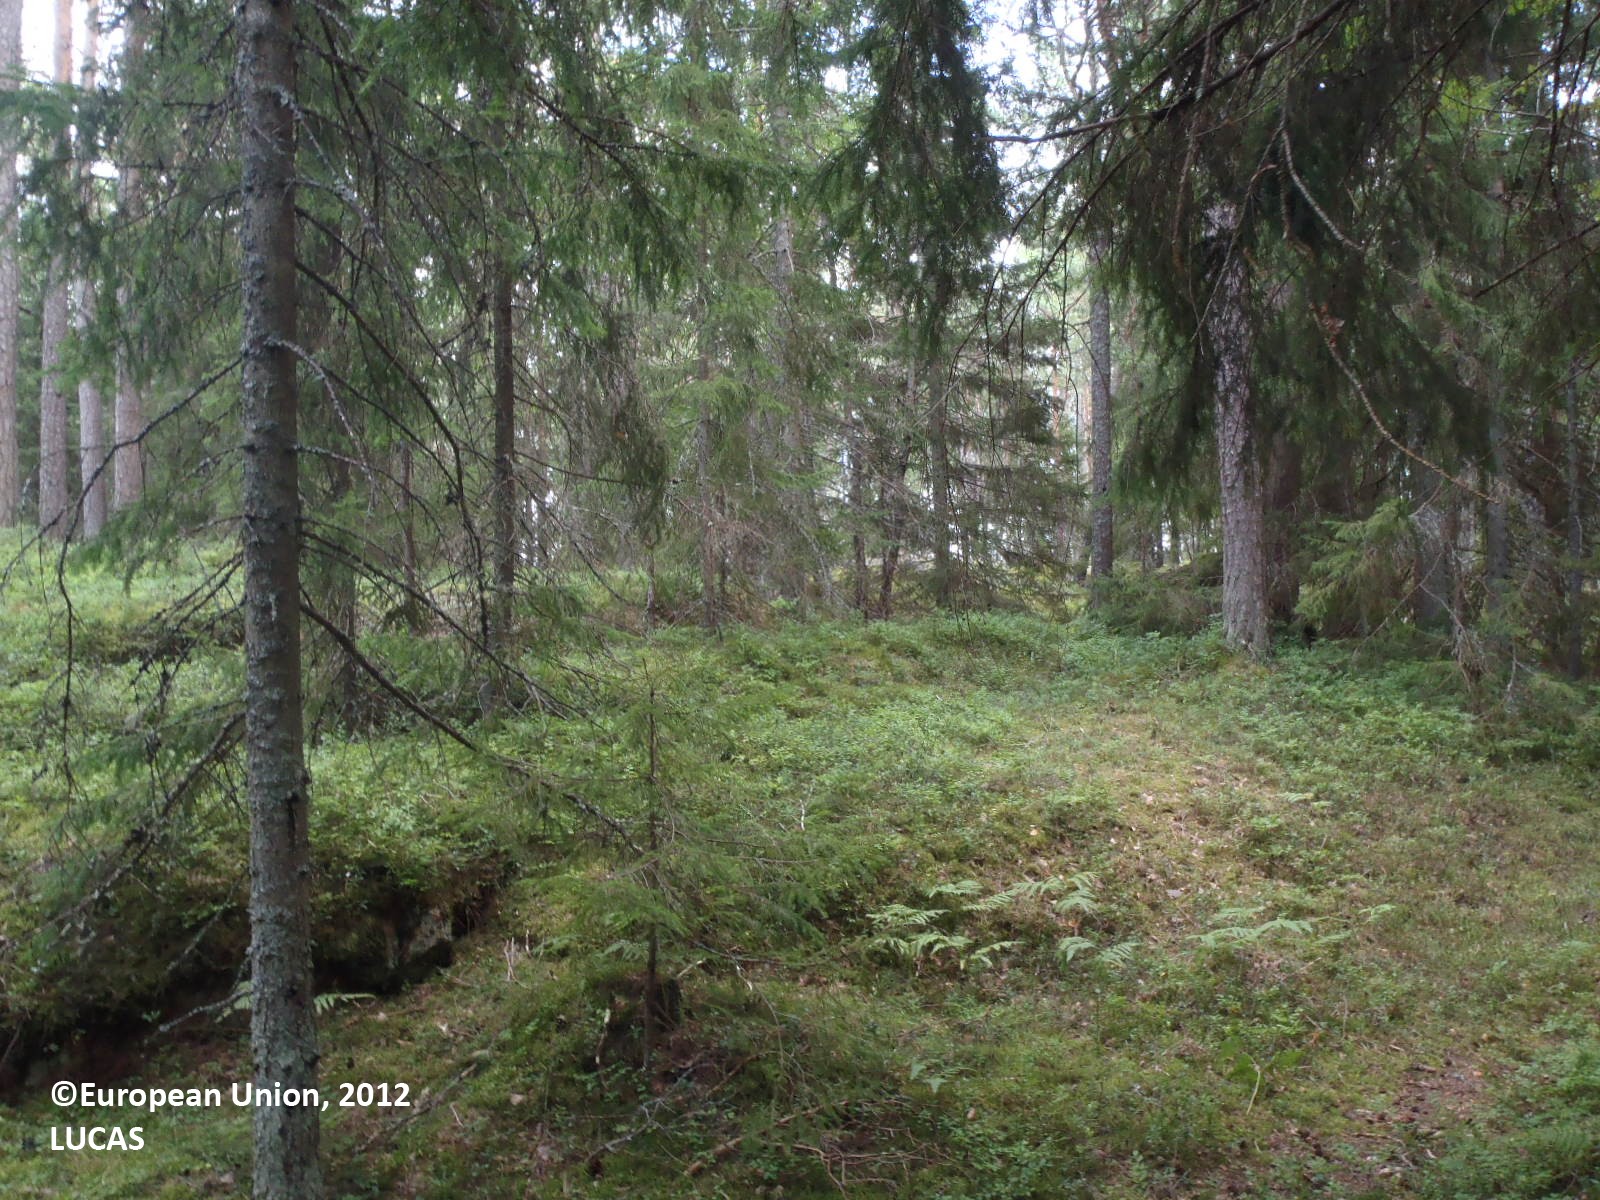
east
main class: Woodland
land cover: Pine dominated coniferous woodland
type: hemiboreal forest and nemoral coniferous forest and mixed broadleaved-coniferous forest
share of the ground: > 75 %
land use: Forestry
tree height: > 5 m
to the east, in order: Pine dominated coniferous woodland; Grassland without tree/shrub cover; Spruce dominated coniferous woodland
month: August
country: FI
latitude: 60.2631
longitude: 19.9648
